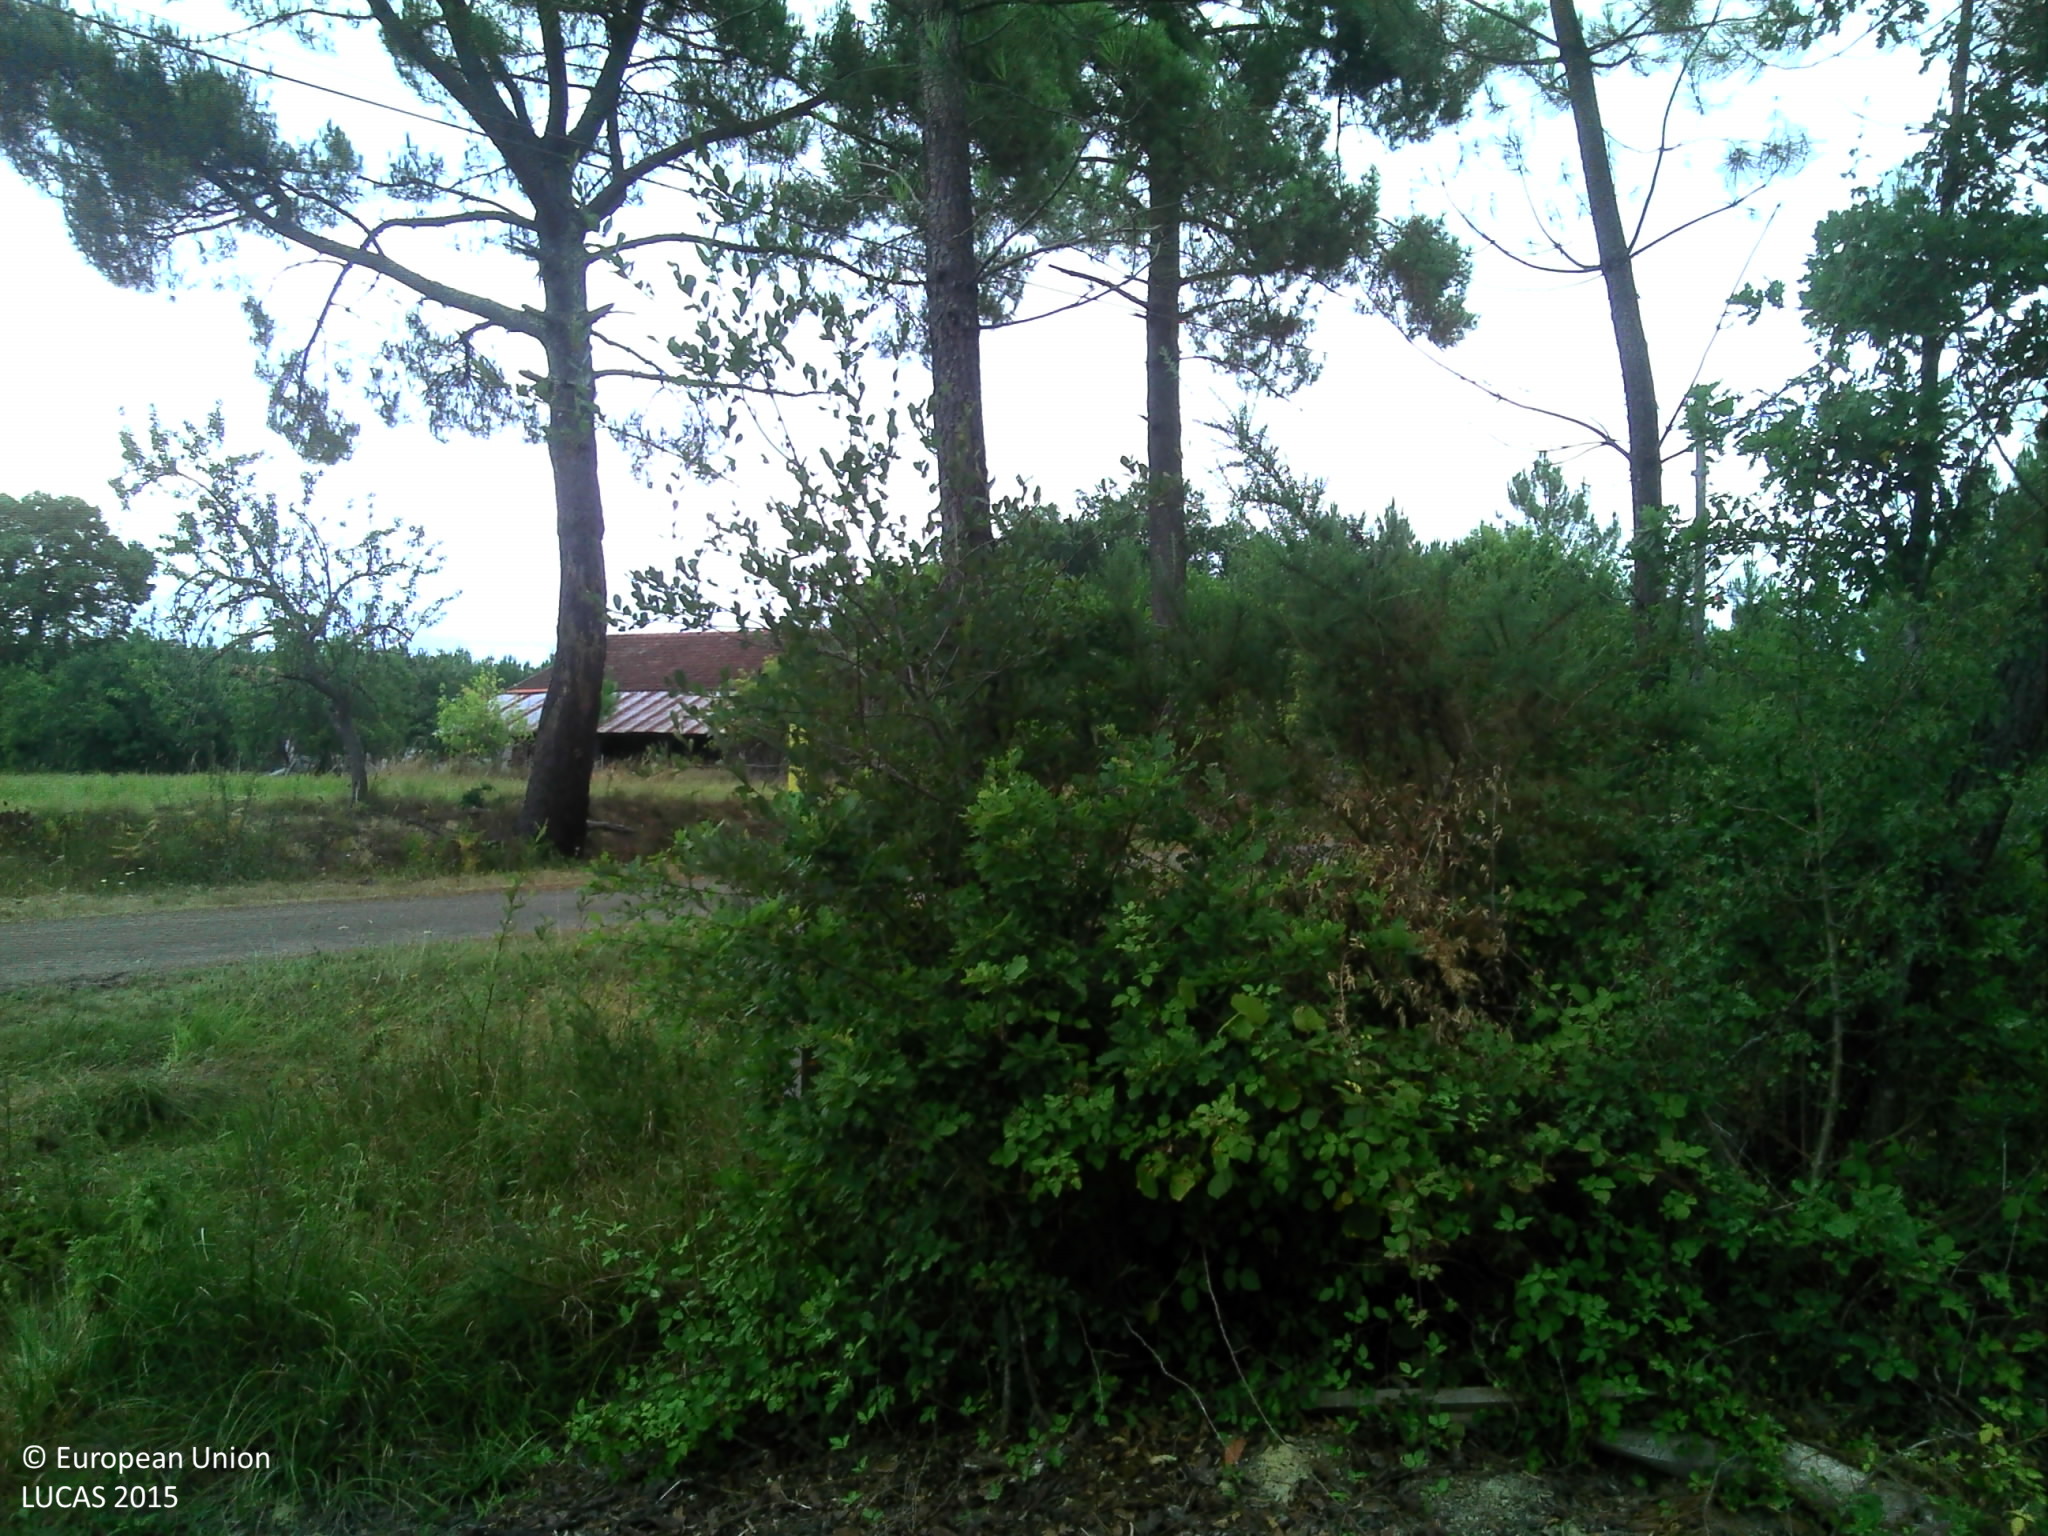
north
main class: Woodland
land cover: Pine dominated coniferous woodland
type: coniferous forest of the mediterranean region
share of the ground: > 75 %
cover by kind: coniferous forest trees 75 %, herbaceous plants 20 %, shrubs 5 %
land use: Forestry
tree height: < 5 m
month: July
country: FR
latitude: 43.9292
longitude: -0.8144
